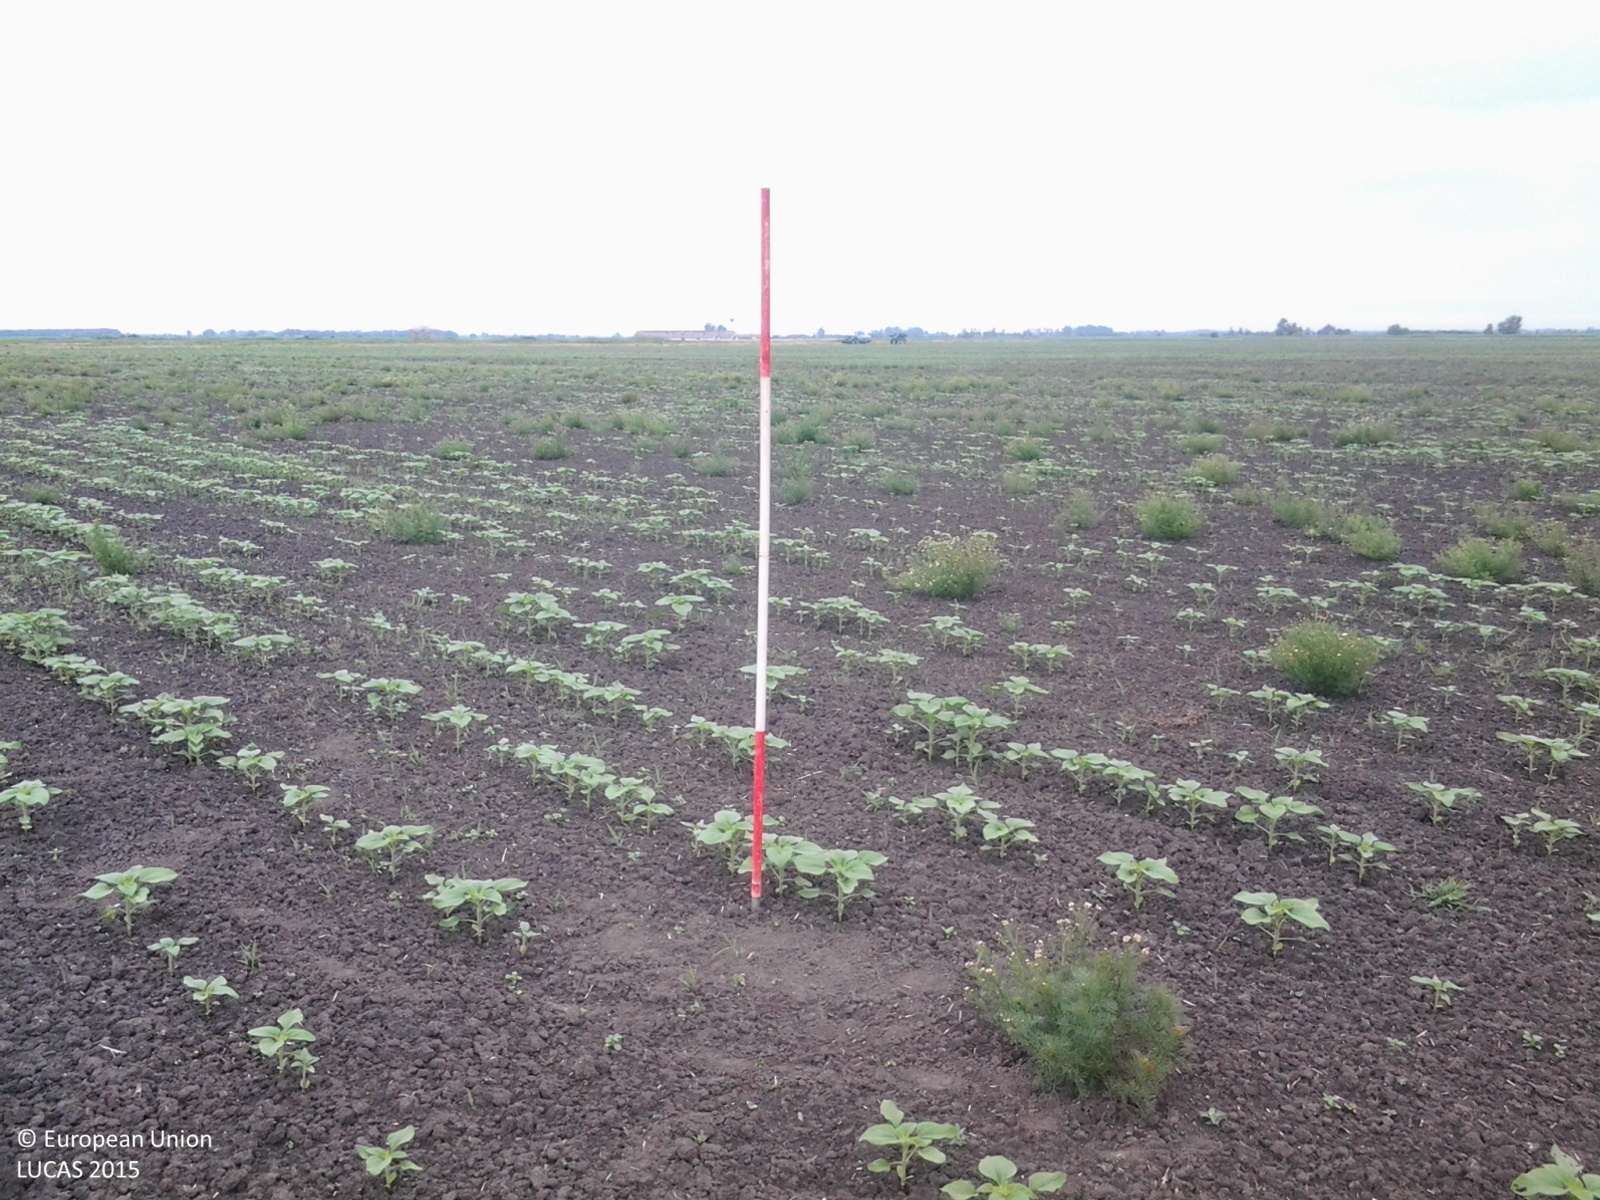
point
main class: Cropland
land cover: Sunflower
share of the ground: < 10 %
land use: Agriculture (excluding fallow land and kitchen gardens)
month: June
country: HU
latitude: 46.8210
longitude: 20.4215
